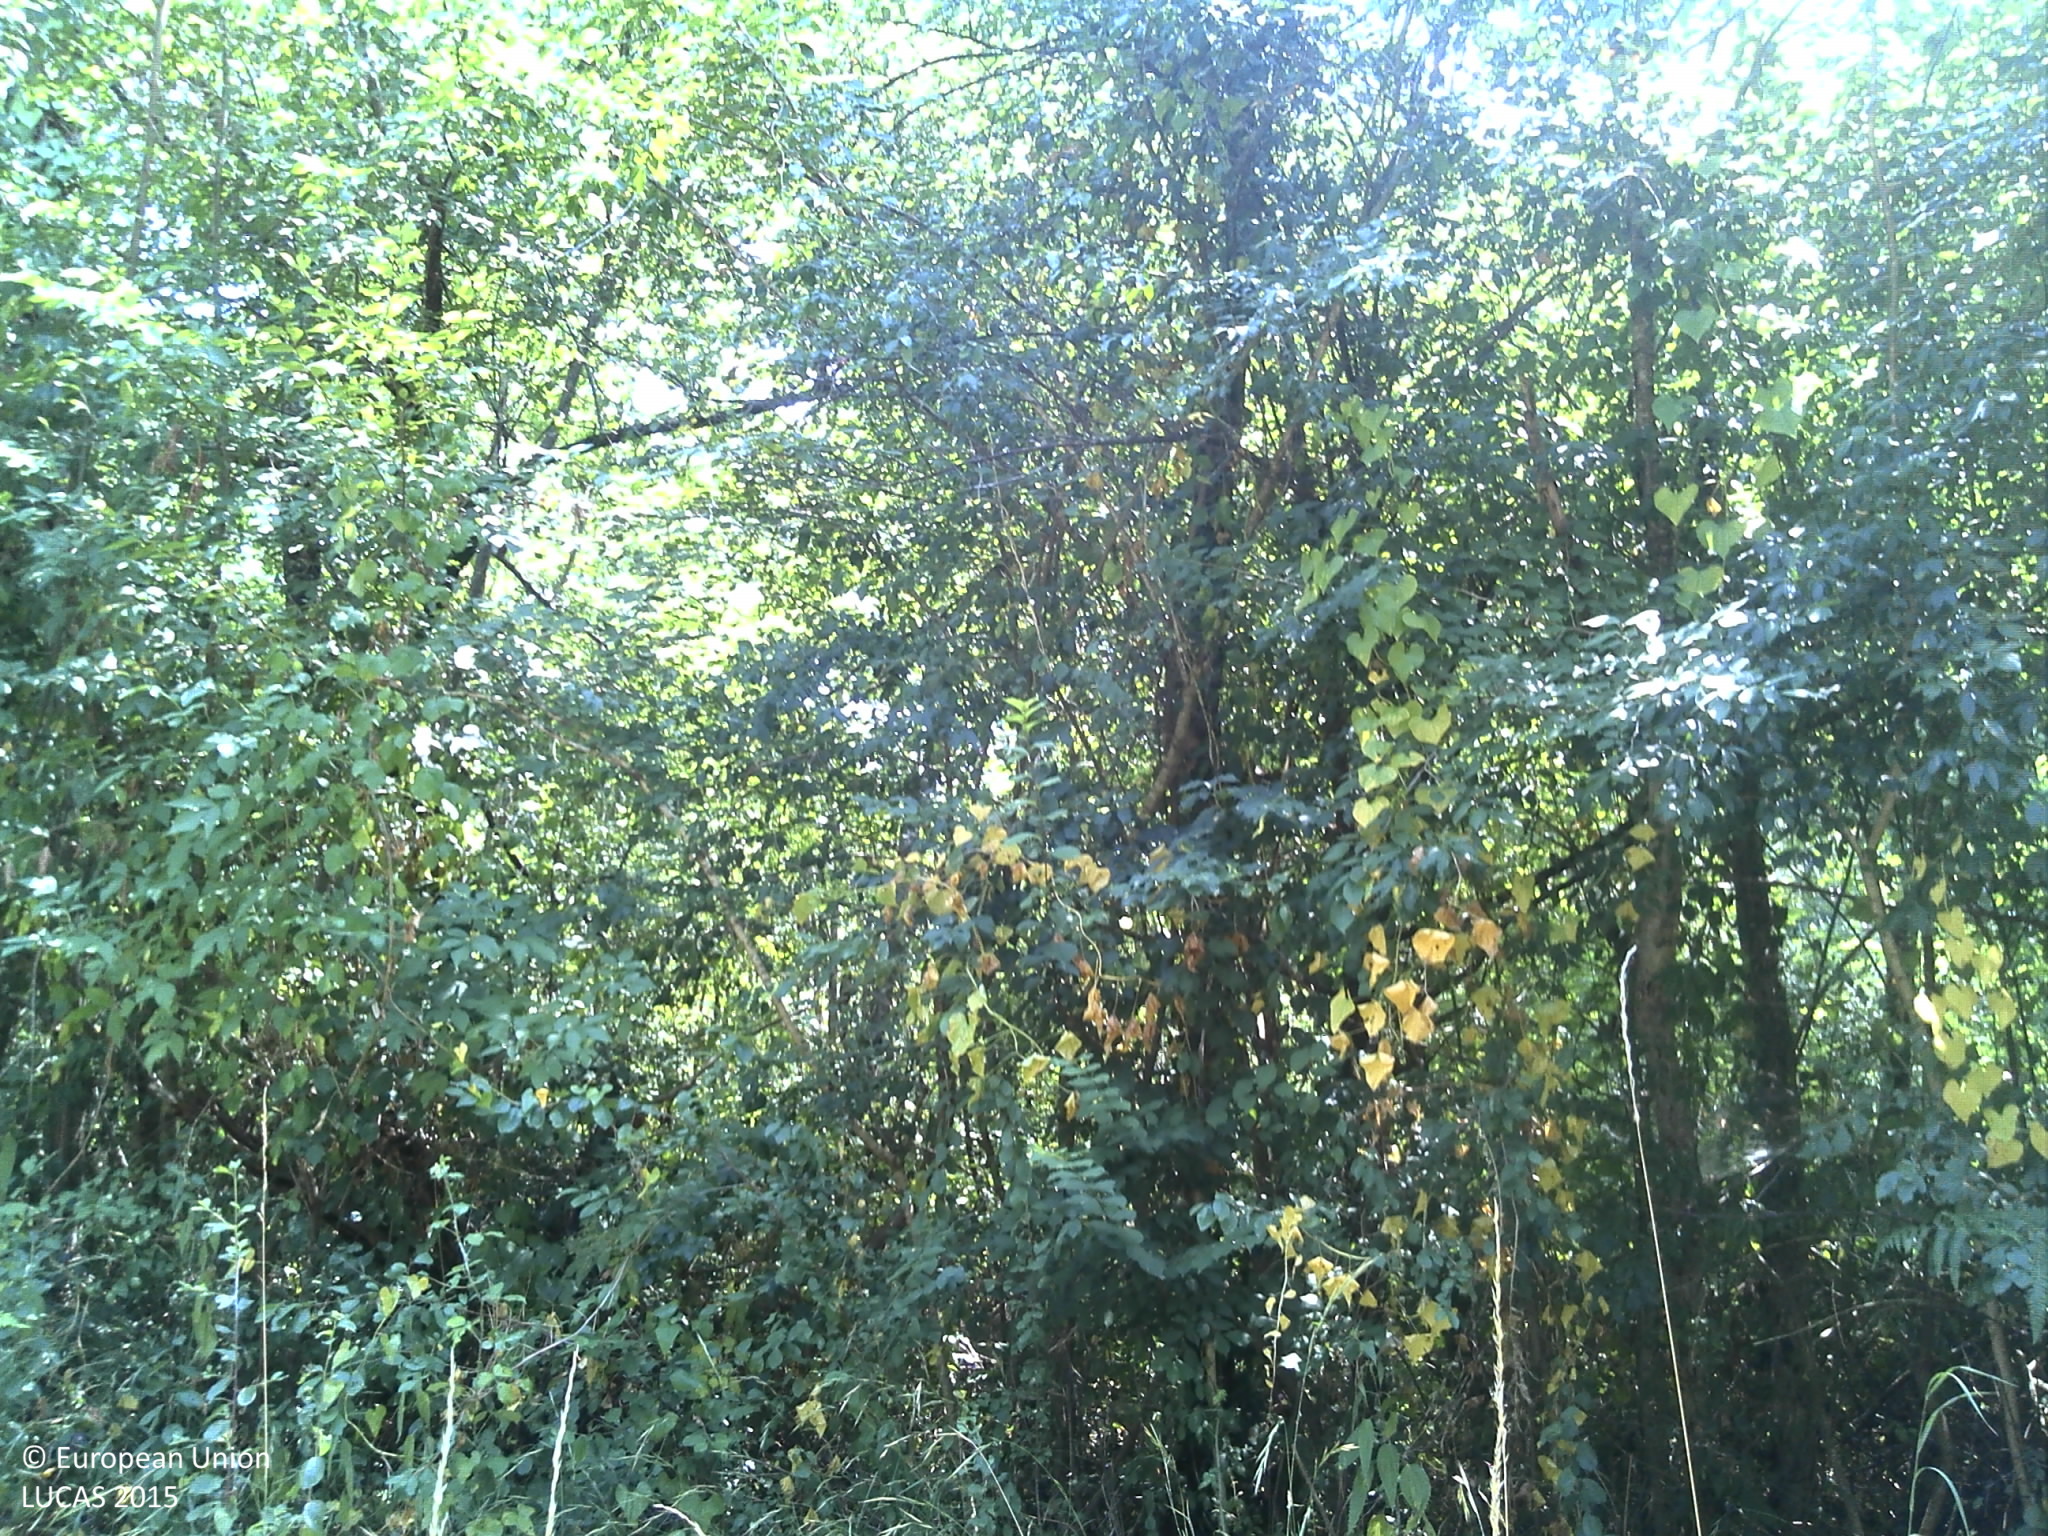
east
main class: Woodland
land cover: Broadleaved woodland
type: mesophytic deciduous forest
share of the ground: > 75 %
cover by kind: broadleaved forest trees 80 %, shrubs 10 %, coniferous forest trees 5 %, herbaceous plants 5 %
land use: Forestry
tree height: > 5 m
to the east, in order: Broadleaved woodland; Tracks; Other mixed woodland
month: July
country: FR
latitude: 44.6450
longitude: -0.3923
